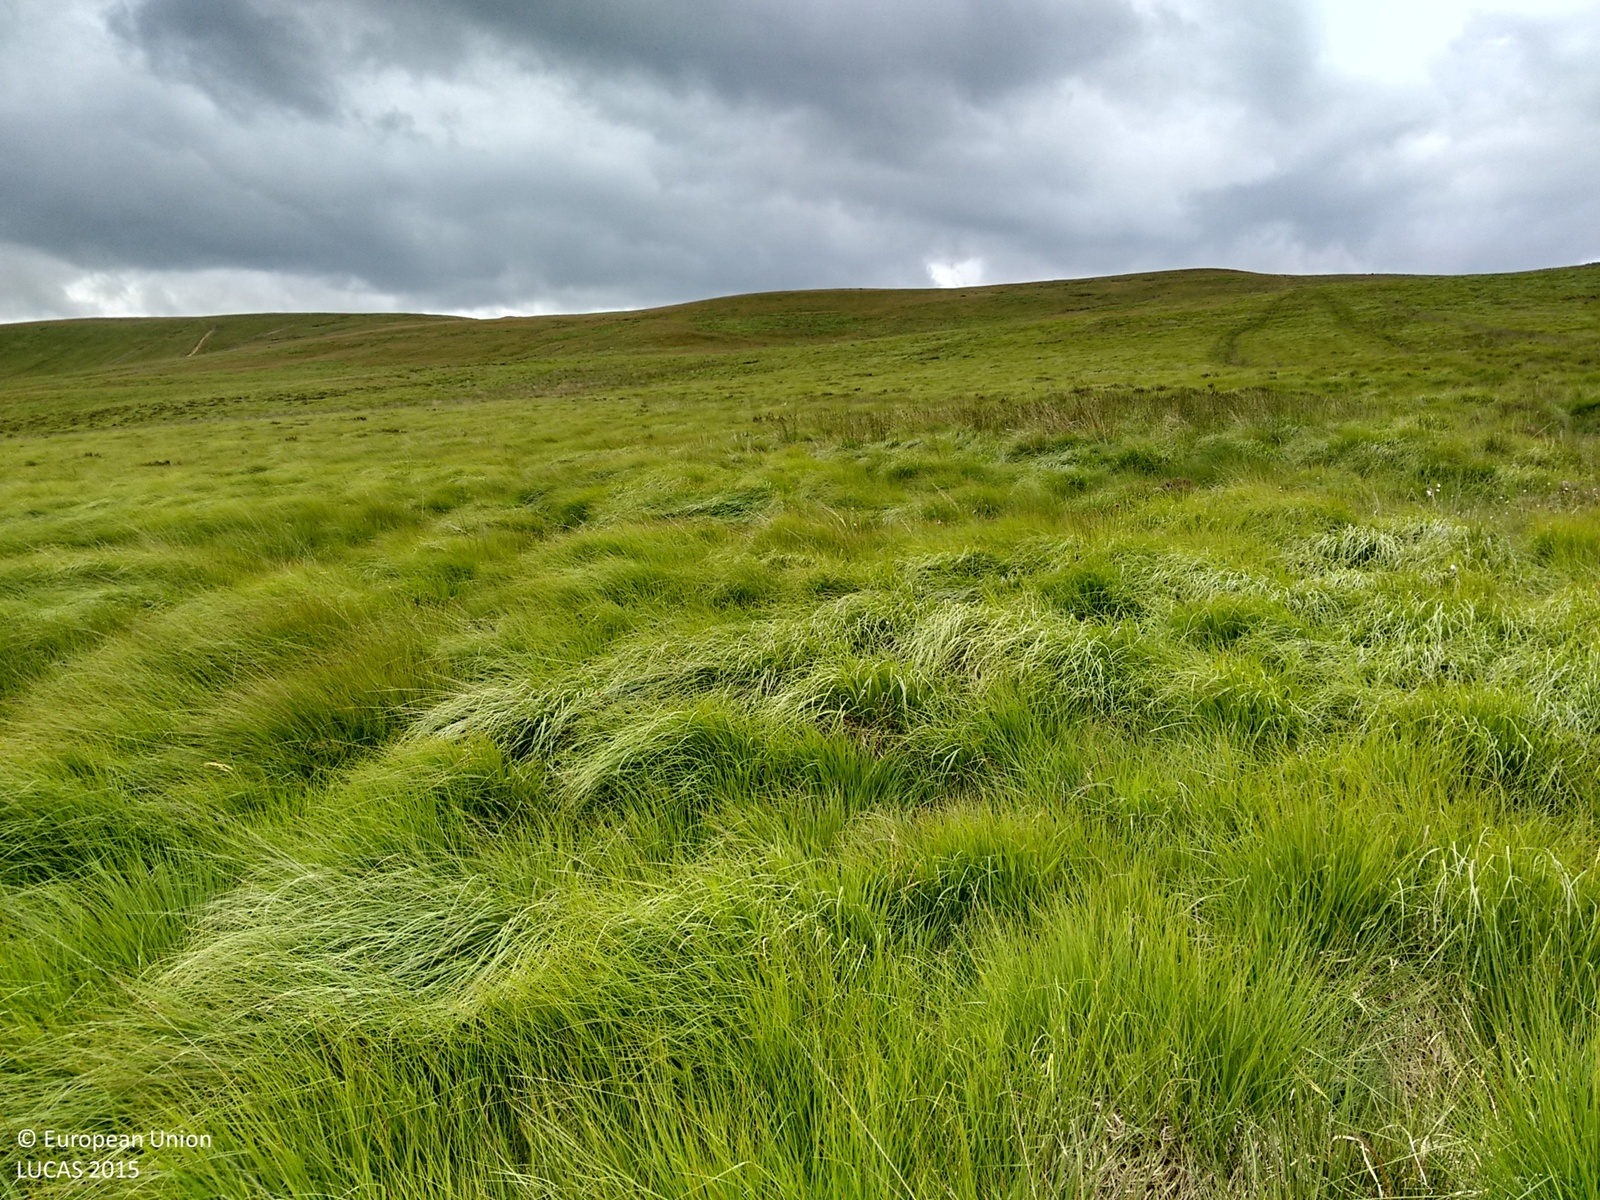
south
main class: Grassland
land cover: Grassland without tree/shrub cover
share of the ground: > 75 %
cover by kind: herbaceous plants 100 %
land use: Semi-natural and natural areas not in use
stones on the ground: < 10 %
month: July
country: GB
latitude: 51.7888
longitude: -3.1400
